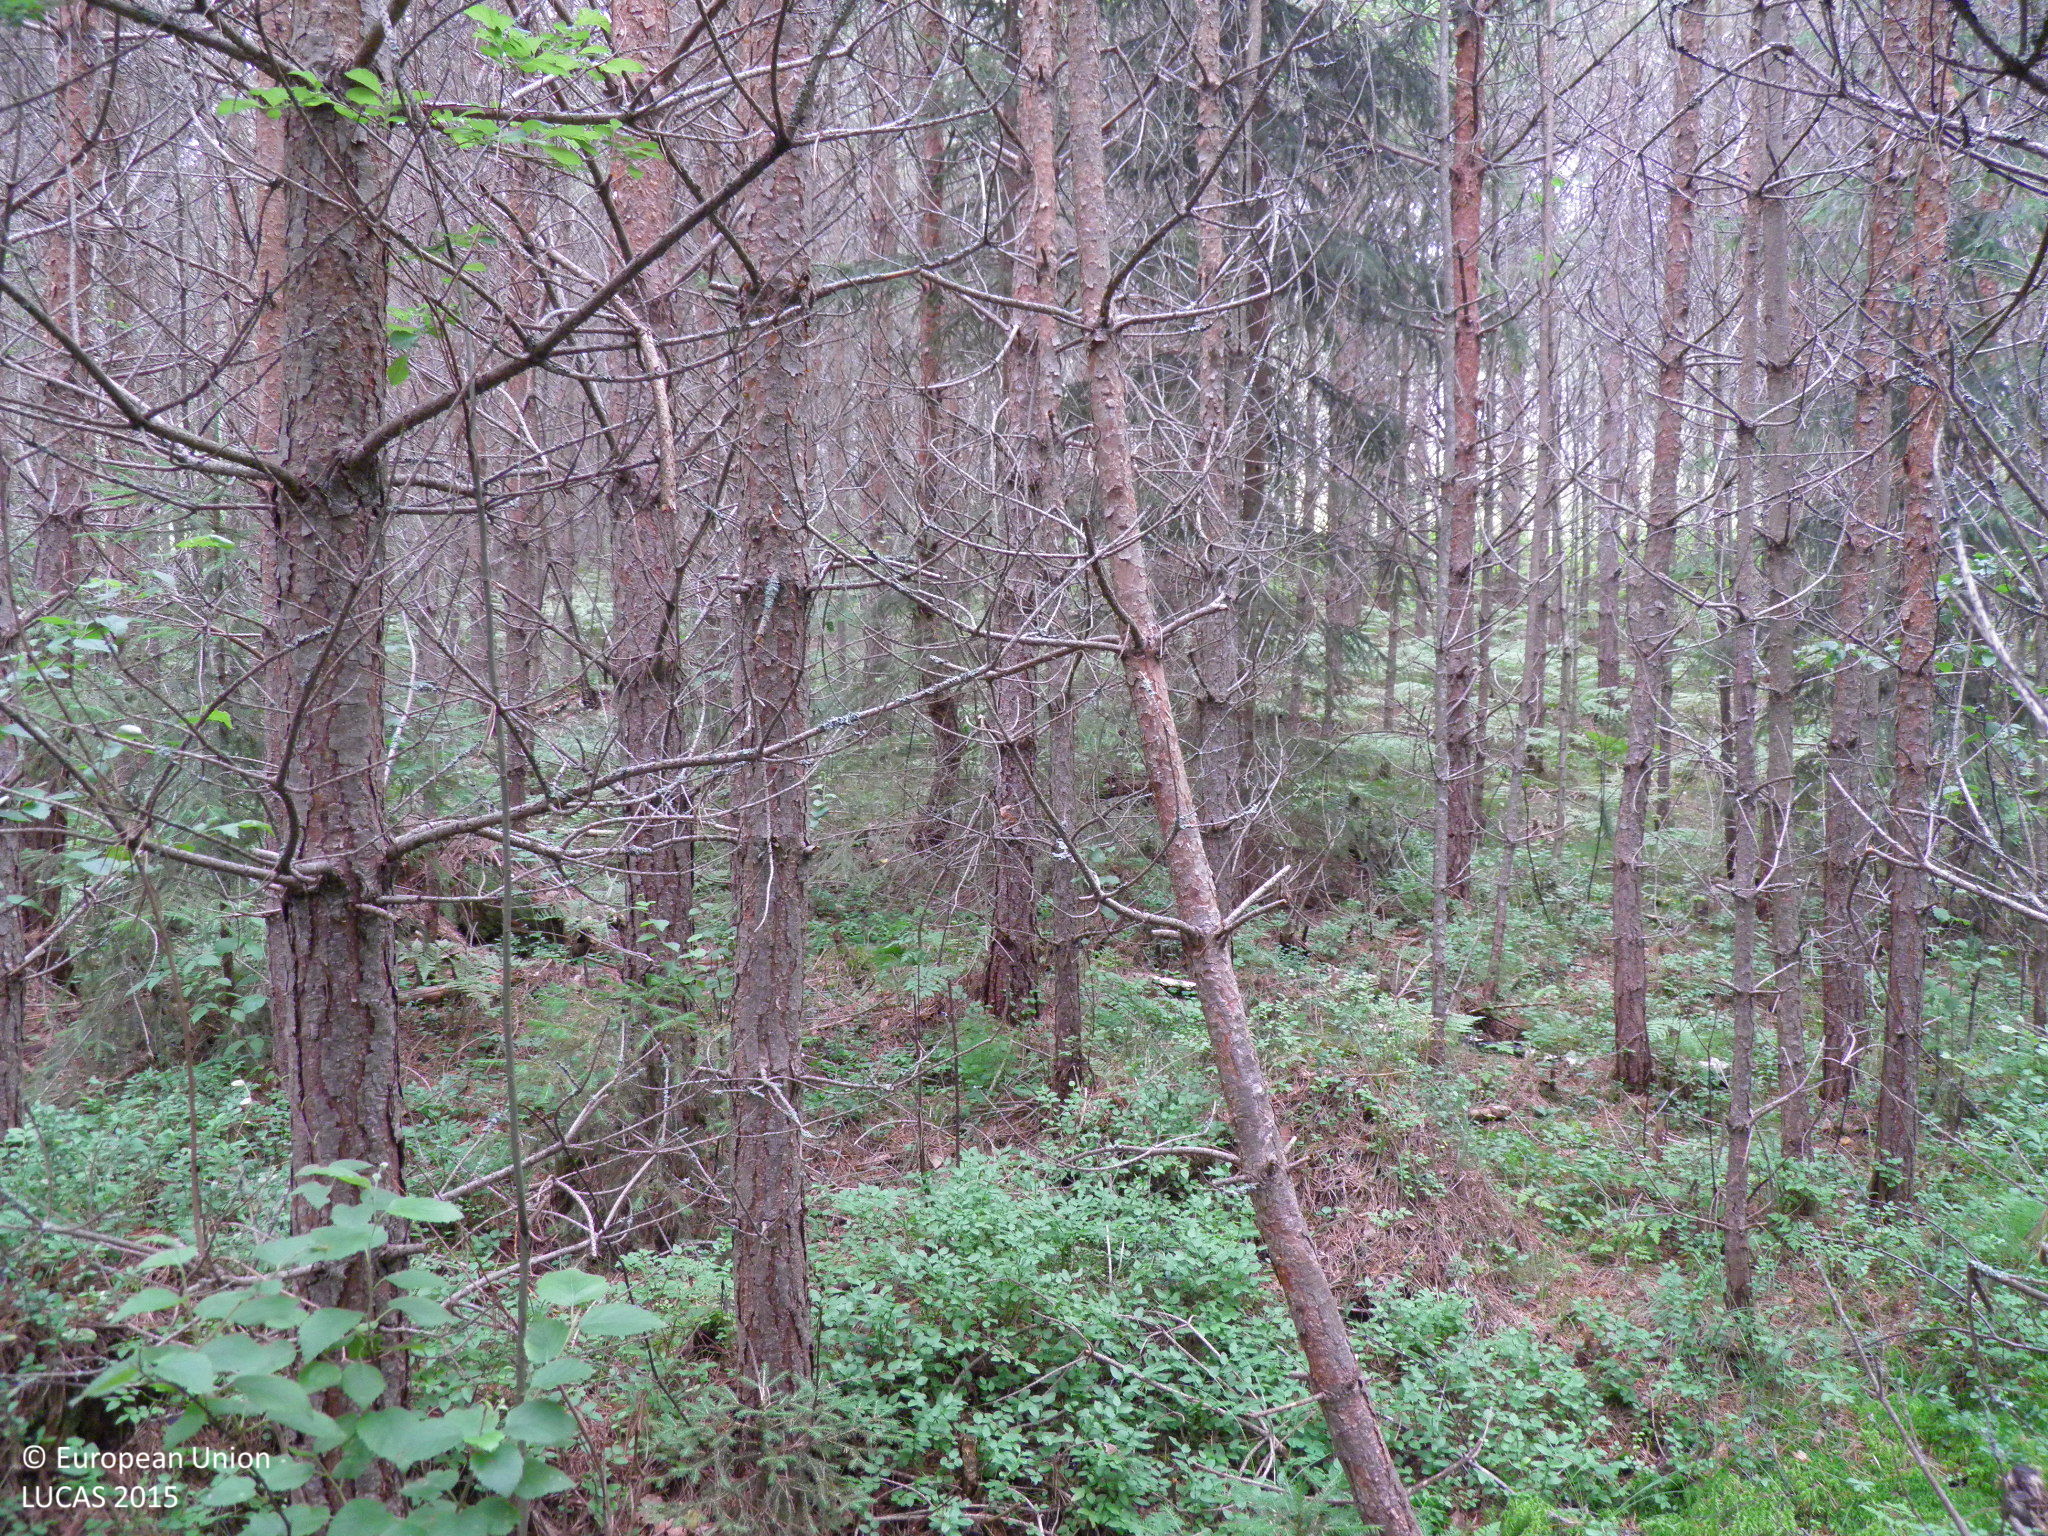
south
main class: Woodland
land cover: Pine dominated mixed woodland
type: hemiboreal forest and nemoral coniferous forest and mixed broadleaved-coniferous forest
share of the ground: > 75 %
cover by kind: coniferous forest trees 50 %, broadleaved forest trees 40 %, shrubs 5 %, herbaceous plants 5 %
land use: Forestry
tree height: > 5 m
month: July
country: FI
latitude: 60.1804
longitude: 22.7867
